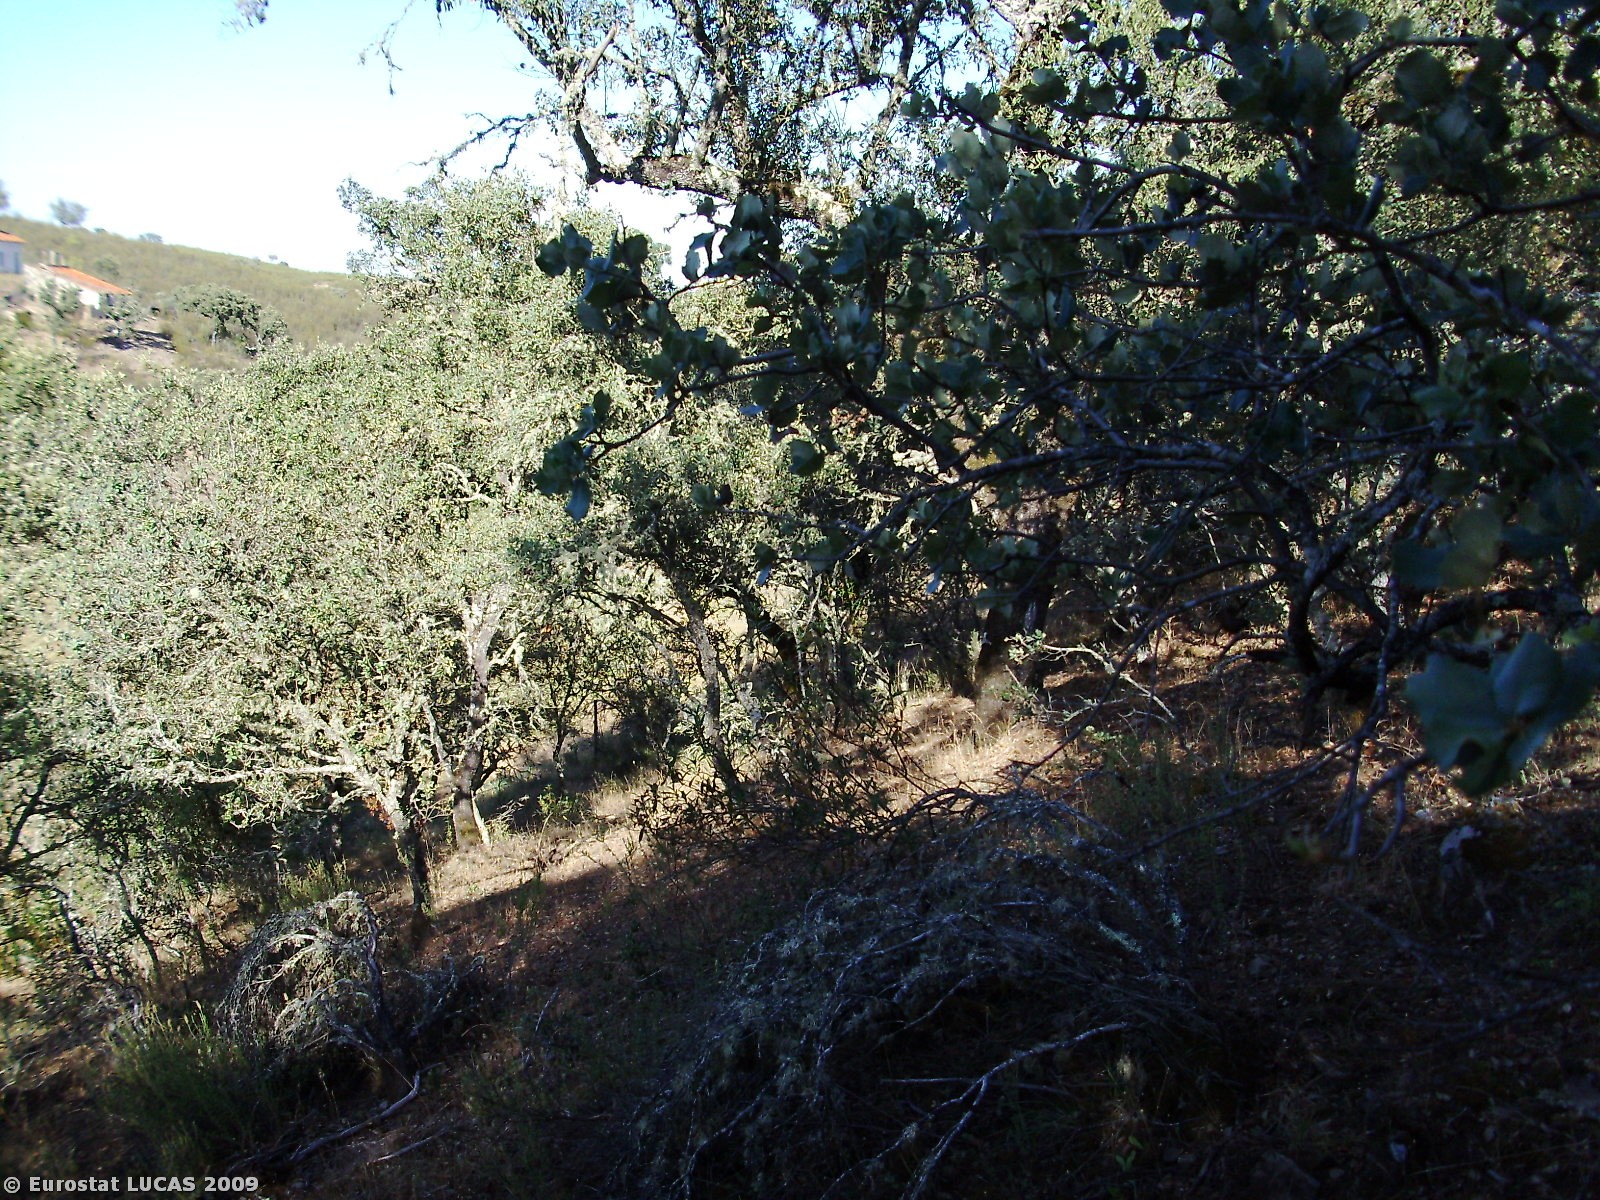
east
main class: Woodland
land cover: Broadleaved woodland
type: broadleaved evergreen forest
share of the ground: 25 - 50 %
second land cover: Shrubland with sparse tree cover
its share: 50 - 75 %
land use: Forestry
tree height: > 5 m
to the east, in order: Broadleaved woodland; Shrubland with sparse tree cover; Broadleaved woodland; Dry stone walls; Grassland without tree/shrub cover
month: April
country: PT
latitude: 39.5281
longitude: -7.5096
